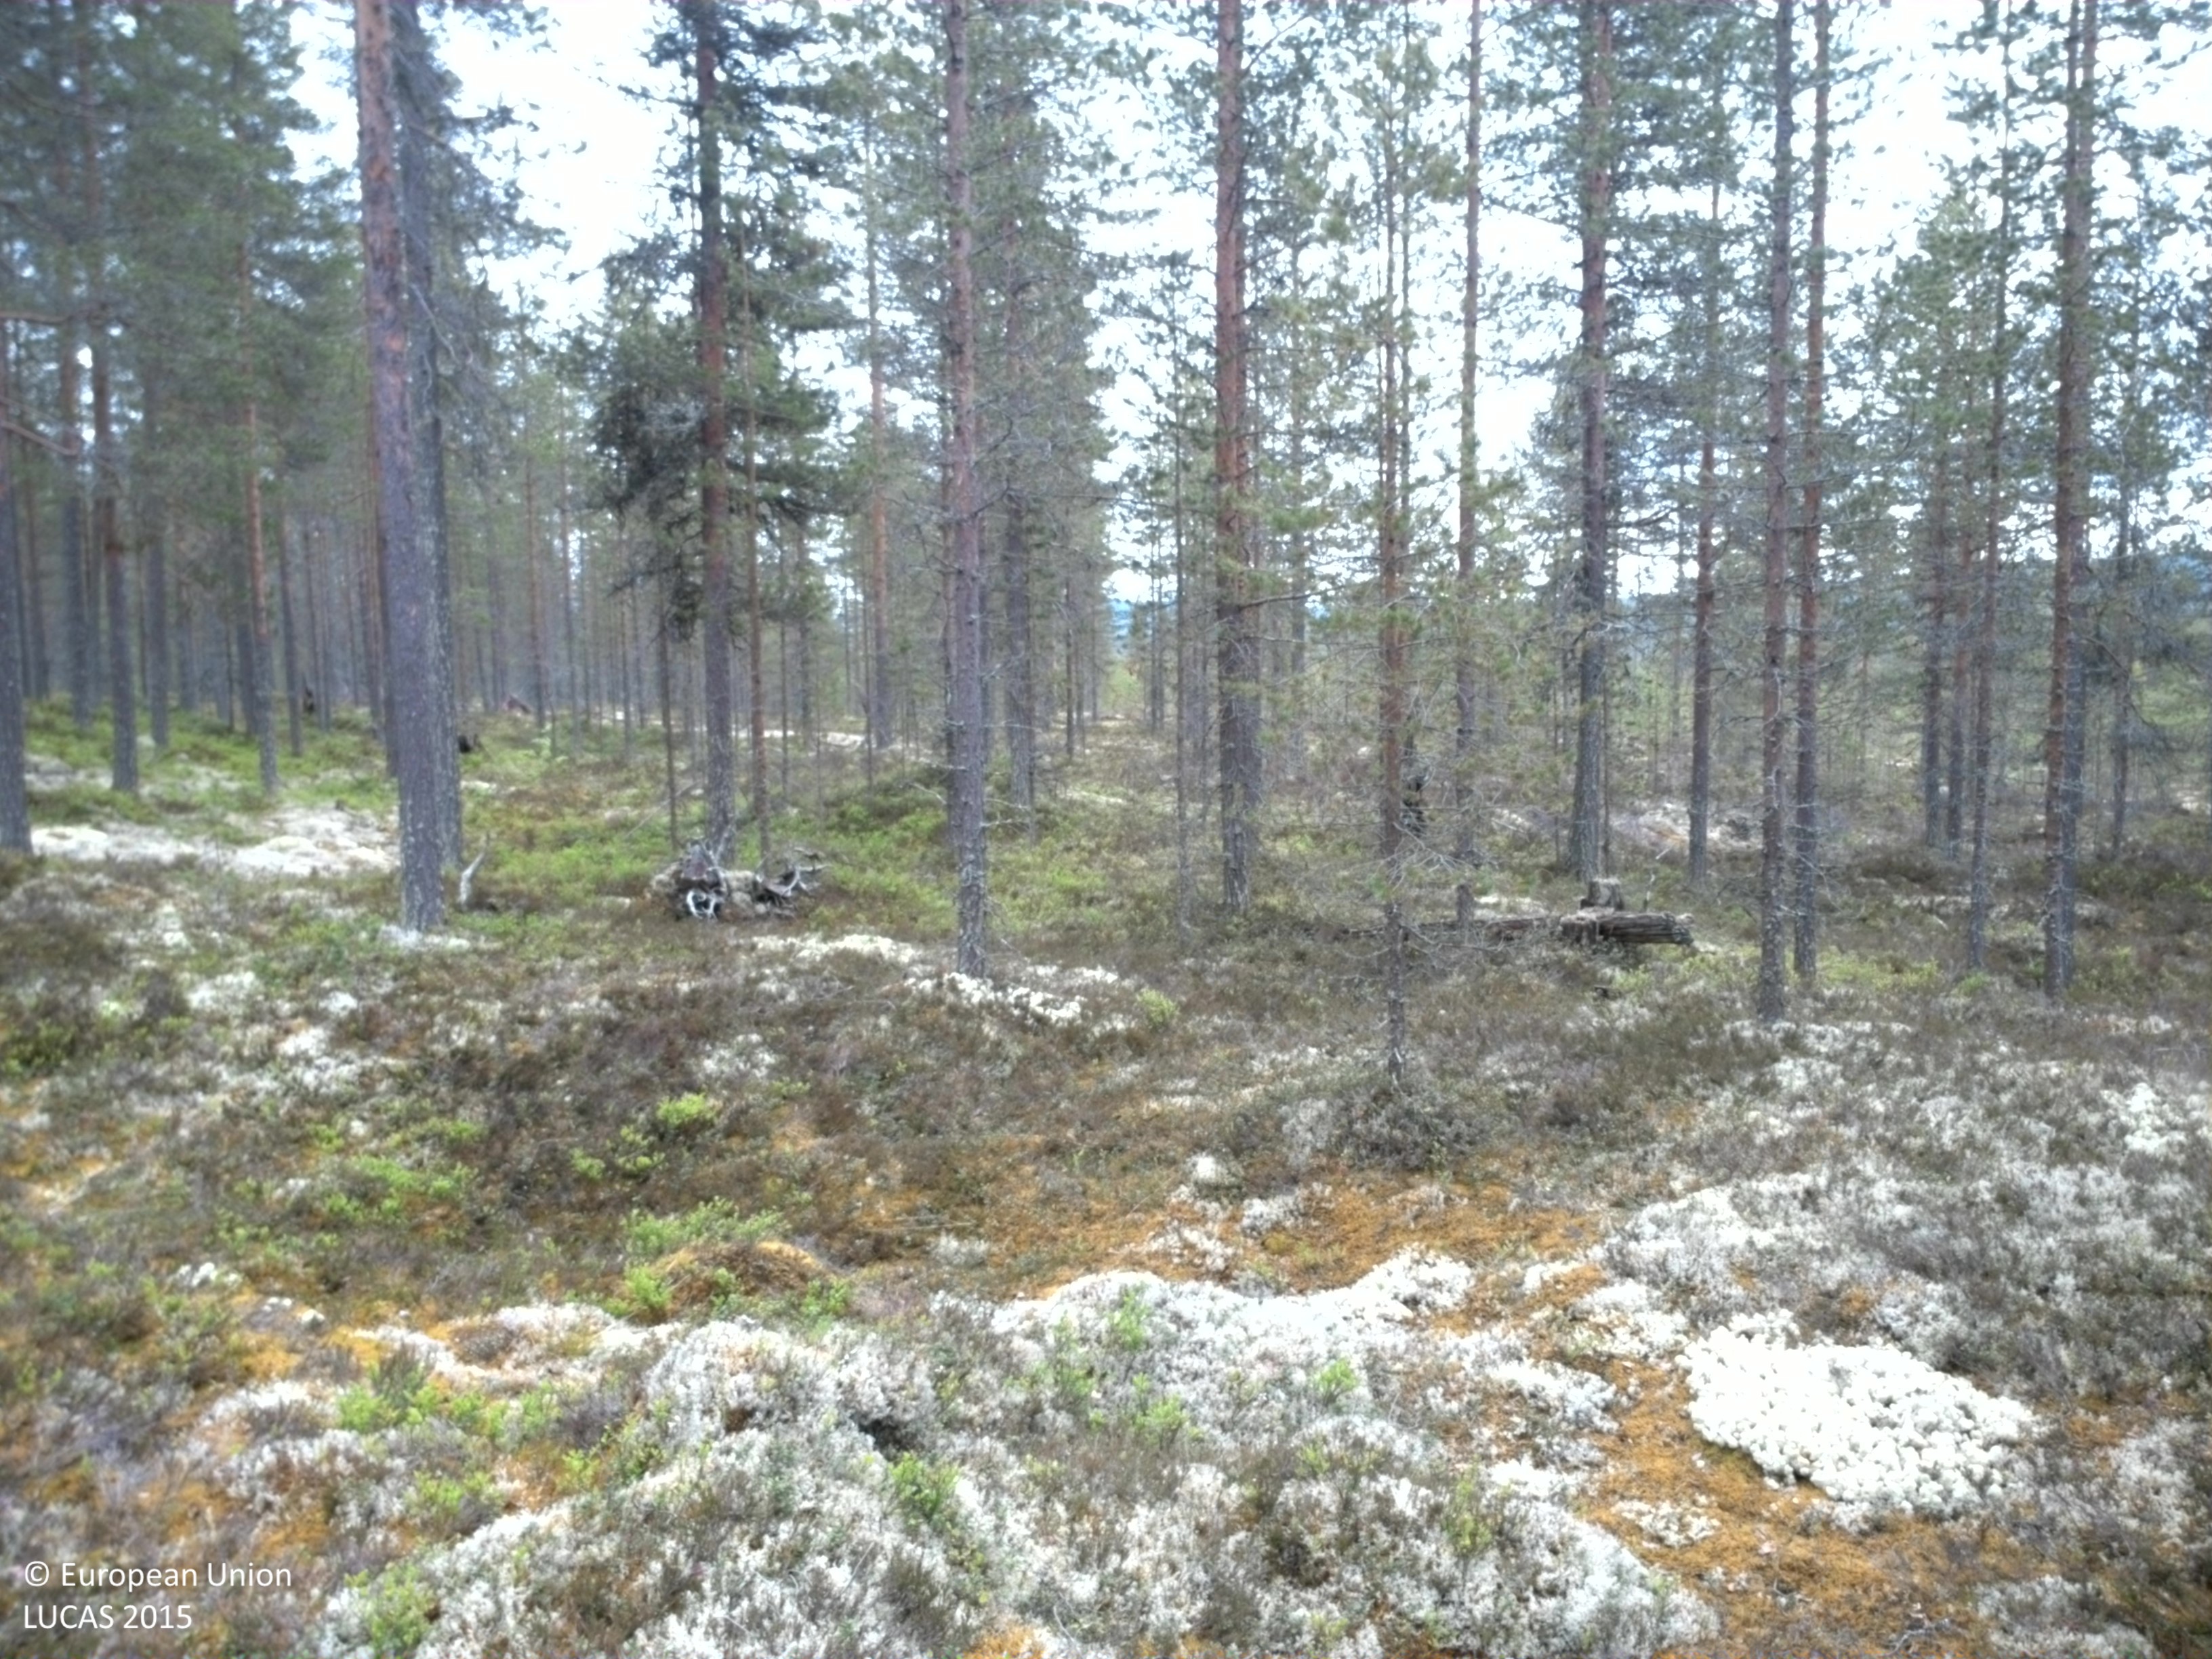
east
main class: Woodland
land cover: Pine dominated coniferous woodland
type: boreal forest
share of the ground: 50 - 75 %
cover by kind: coniferous forest trees 60 %, lichens and mosses 25 %, herbaceous plants 15 %
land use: Forestry
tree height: > 5 m
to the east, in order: Pine dominated coniferous woodland
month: June
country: SE
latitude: 61.4496
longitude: 13.6446
